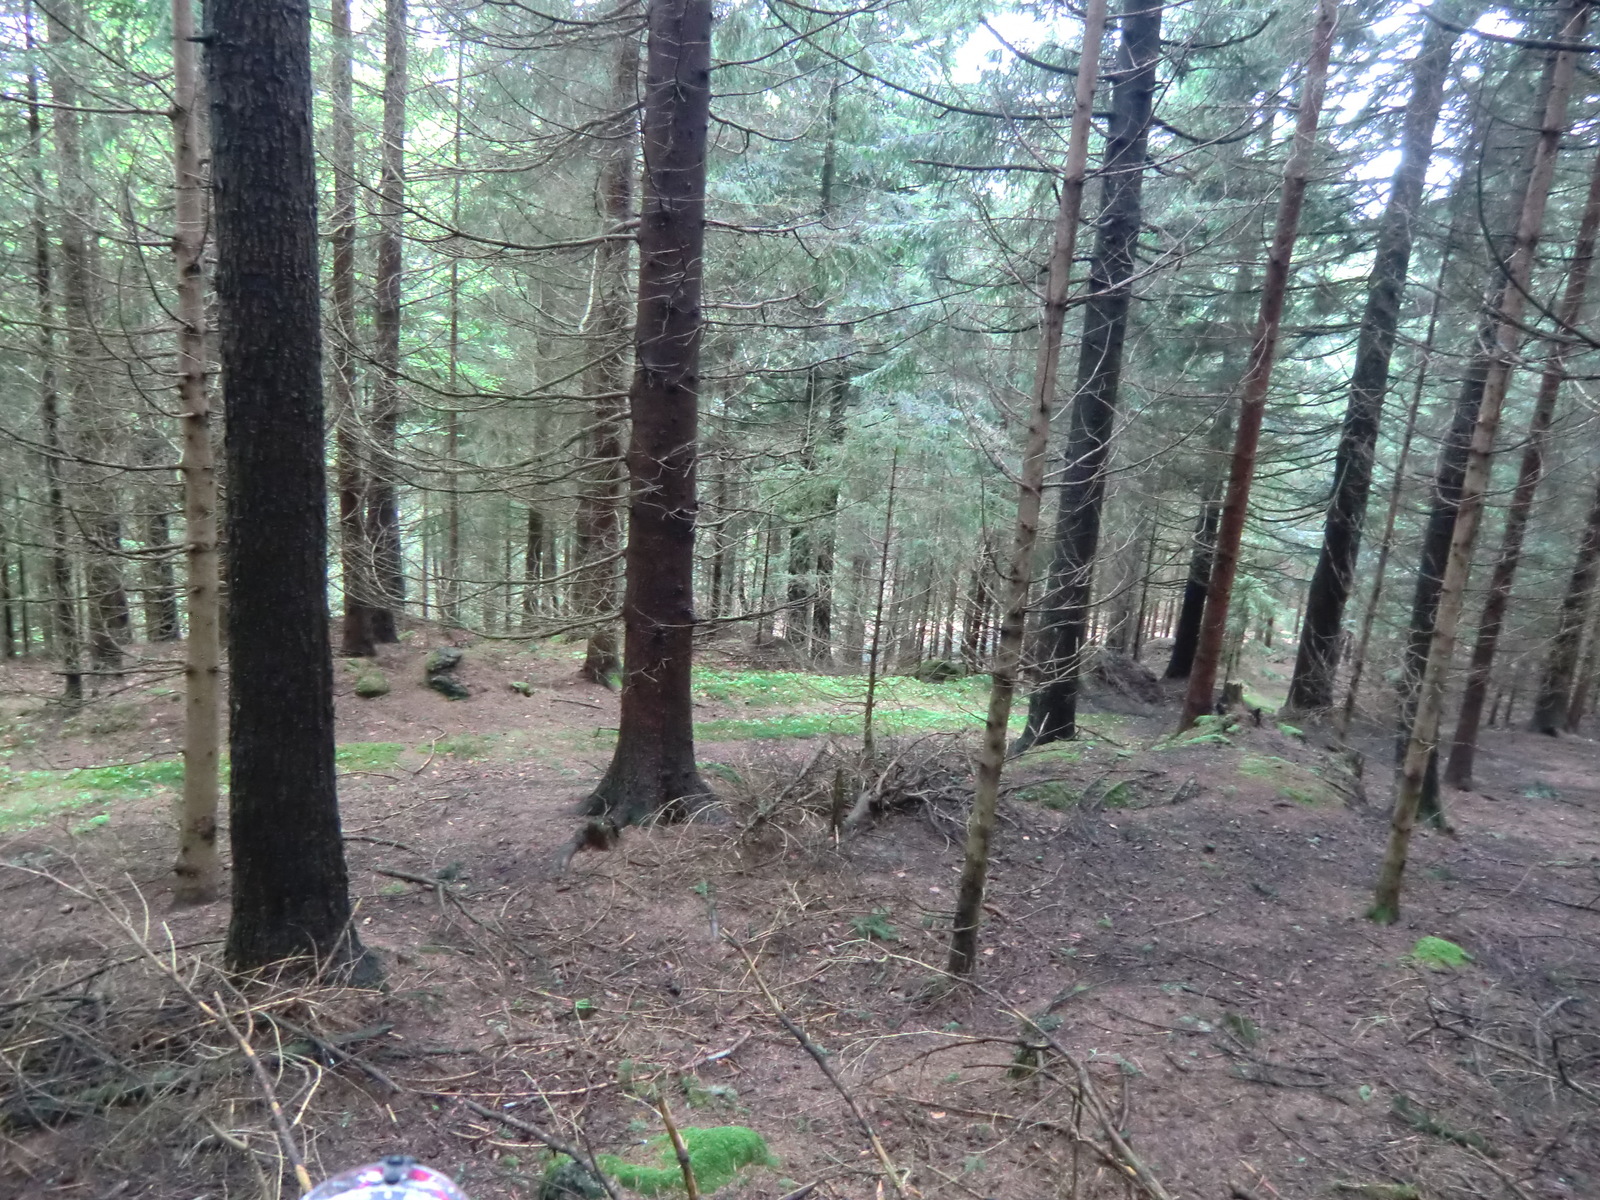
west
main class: Woodland
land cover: Spruce dominated coniferous woodland
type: hemiboreal forest and nemoral coniferous forest and mixed broadleaved-coniferous forest
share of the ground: > 75 %
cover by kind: coniferous forest trees 80 %, unconsolidated bare surface 10 %, lichens and mosses 5 %
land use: Forestry
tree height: > 5 m
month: May
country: AT
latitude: 48.3190
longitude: 14.7614
